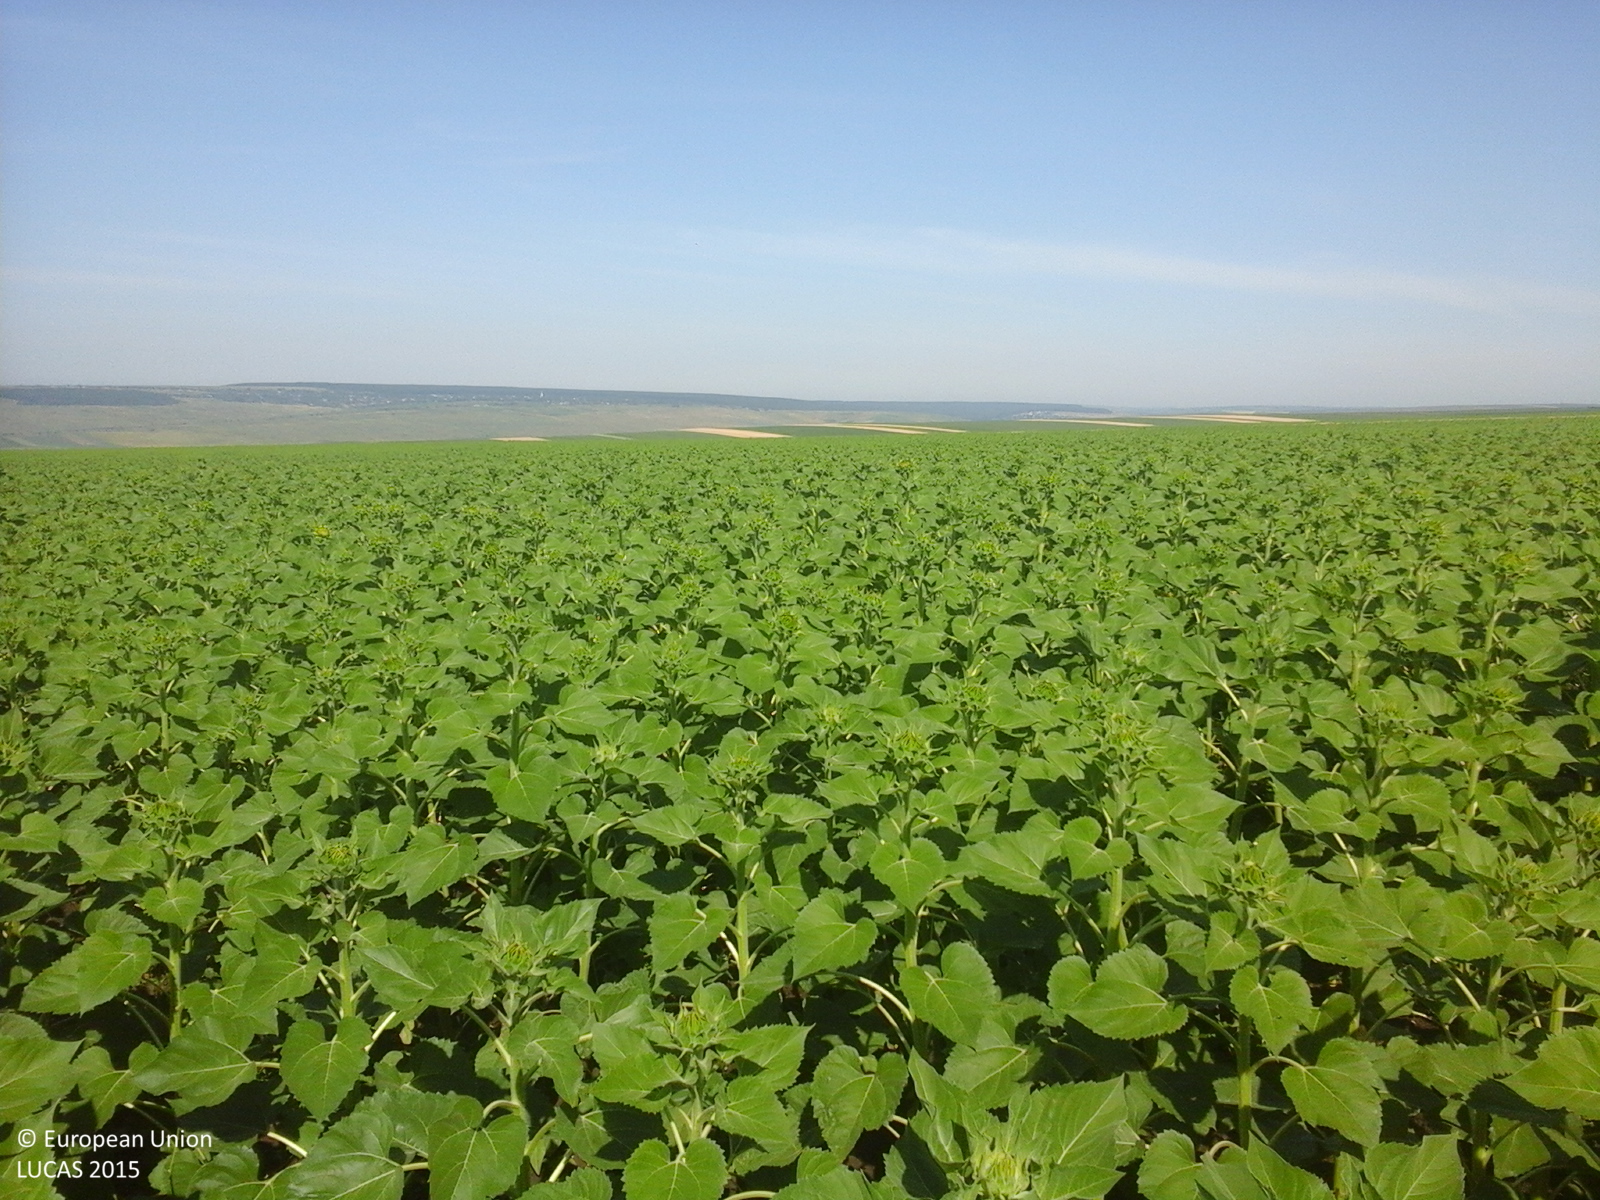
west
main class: Cropland
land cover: Sunflower
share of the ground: > 75 %
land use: Agriculture (excluding fallow land and kitchen gardens)
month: June
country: RO
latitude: 47.7235
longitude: 27.0783
